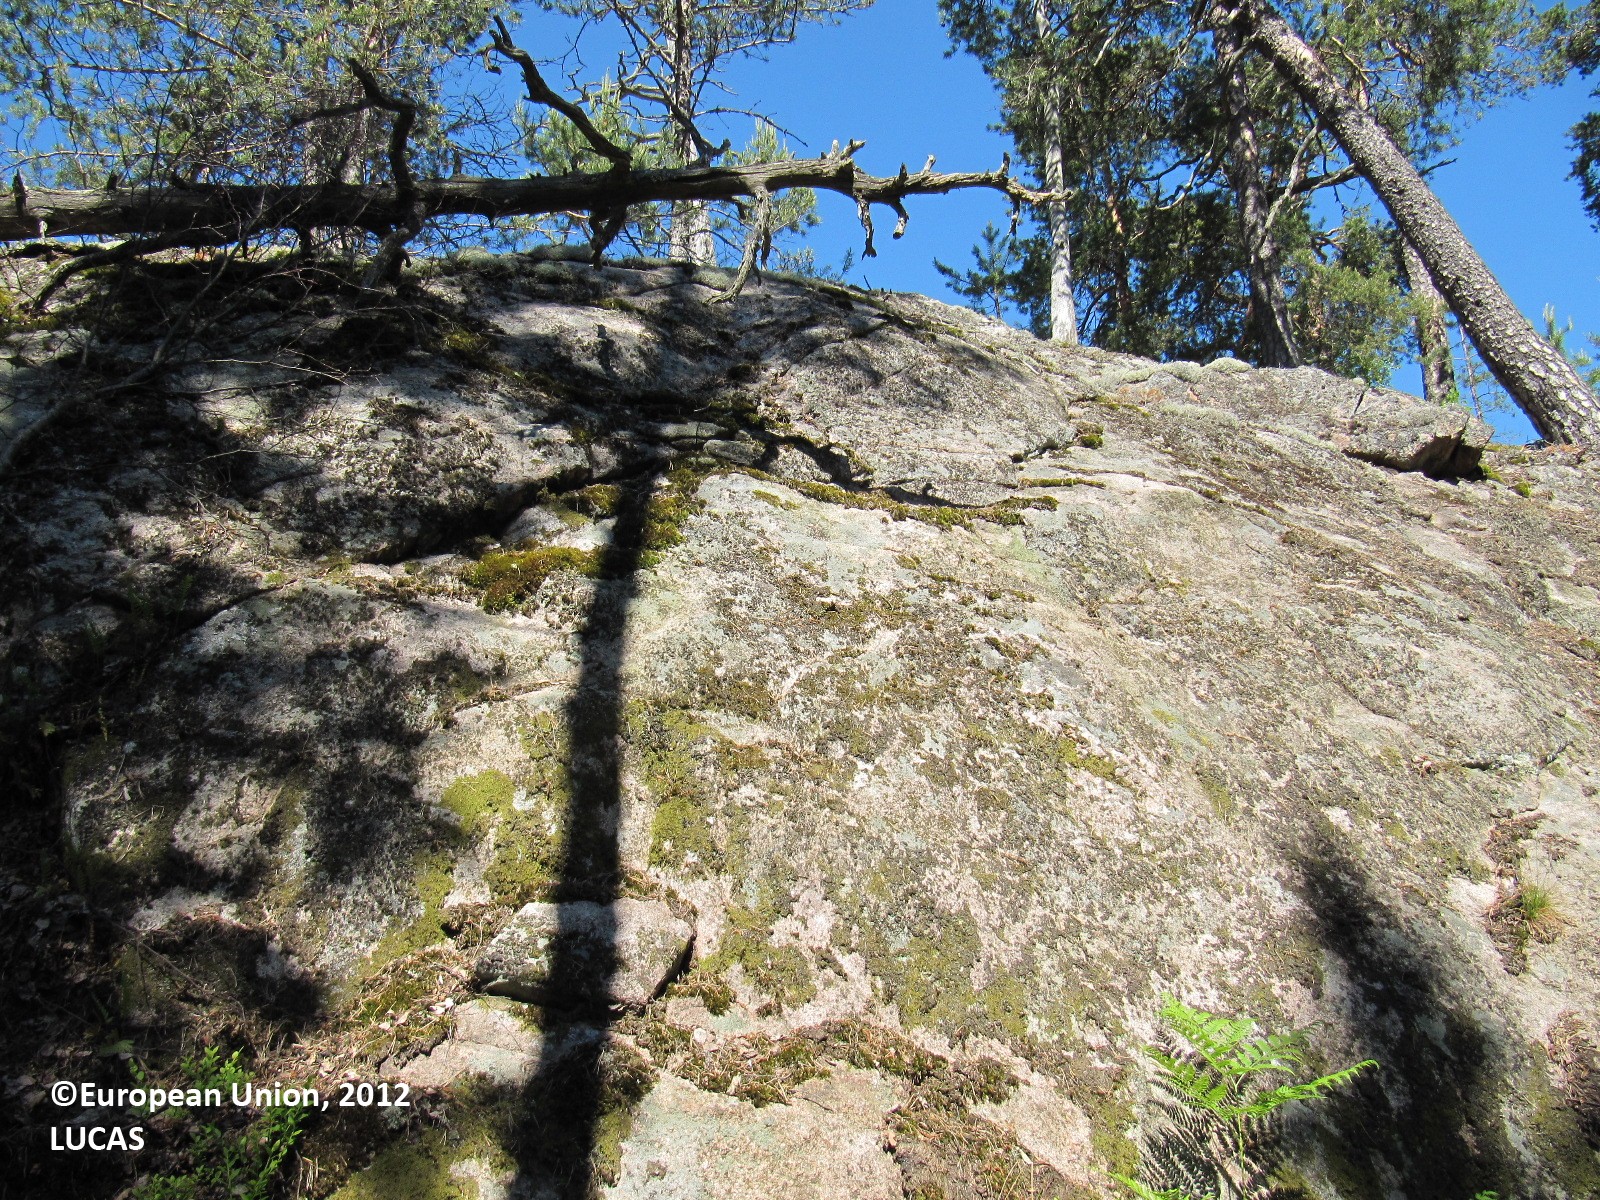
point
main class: Woodland
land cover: Pine dominated mixed woodland
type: boreal forest
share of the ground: 25 - 50 %
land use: Forestry
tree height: > 5 m
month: June
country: FI
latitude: 60.1495
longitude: 24.2424
